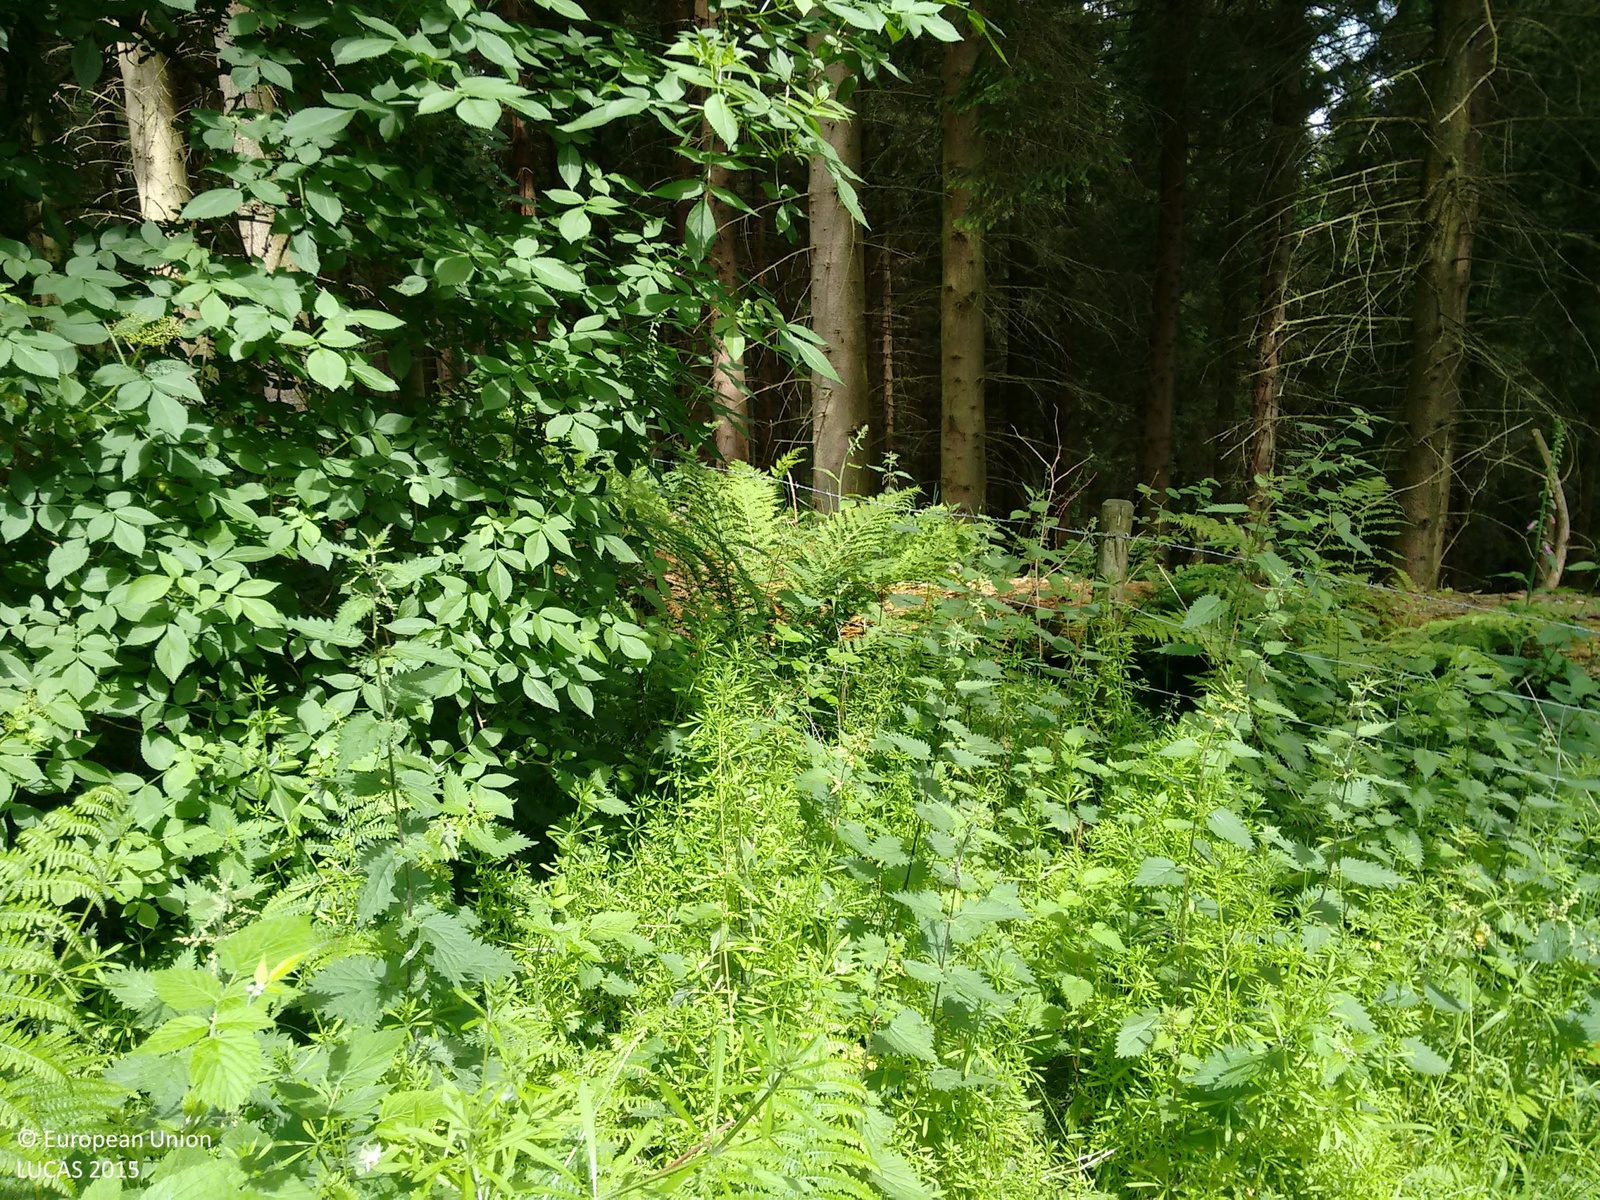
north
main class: Woodland
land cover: Spruce dominated coniferous woodland
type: exotic forest
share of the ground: > 75 %
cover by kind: coniferous forest trees 100 %
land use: Forestry
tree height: > 5 m
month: June
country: GB
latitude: 53.3922
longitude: -1.7376
